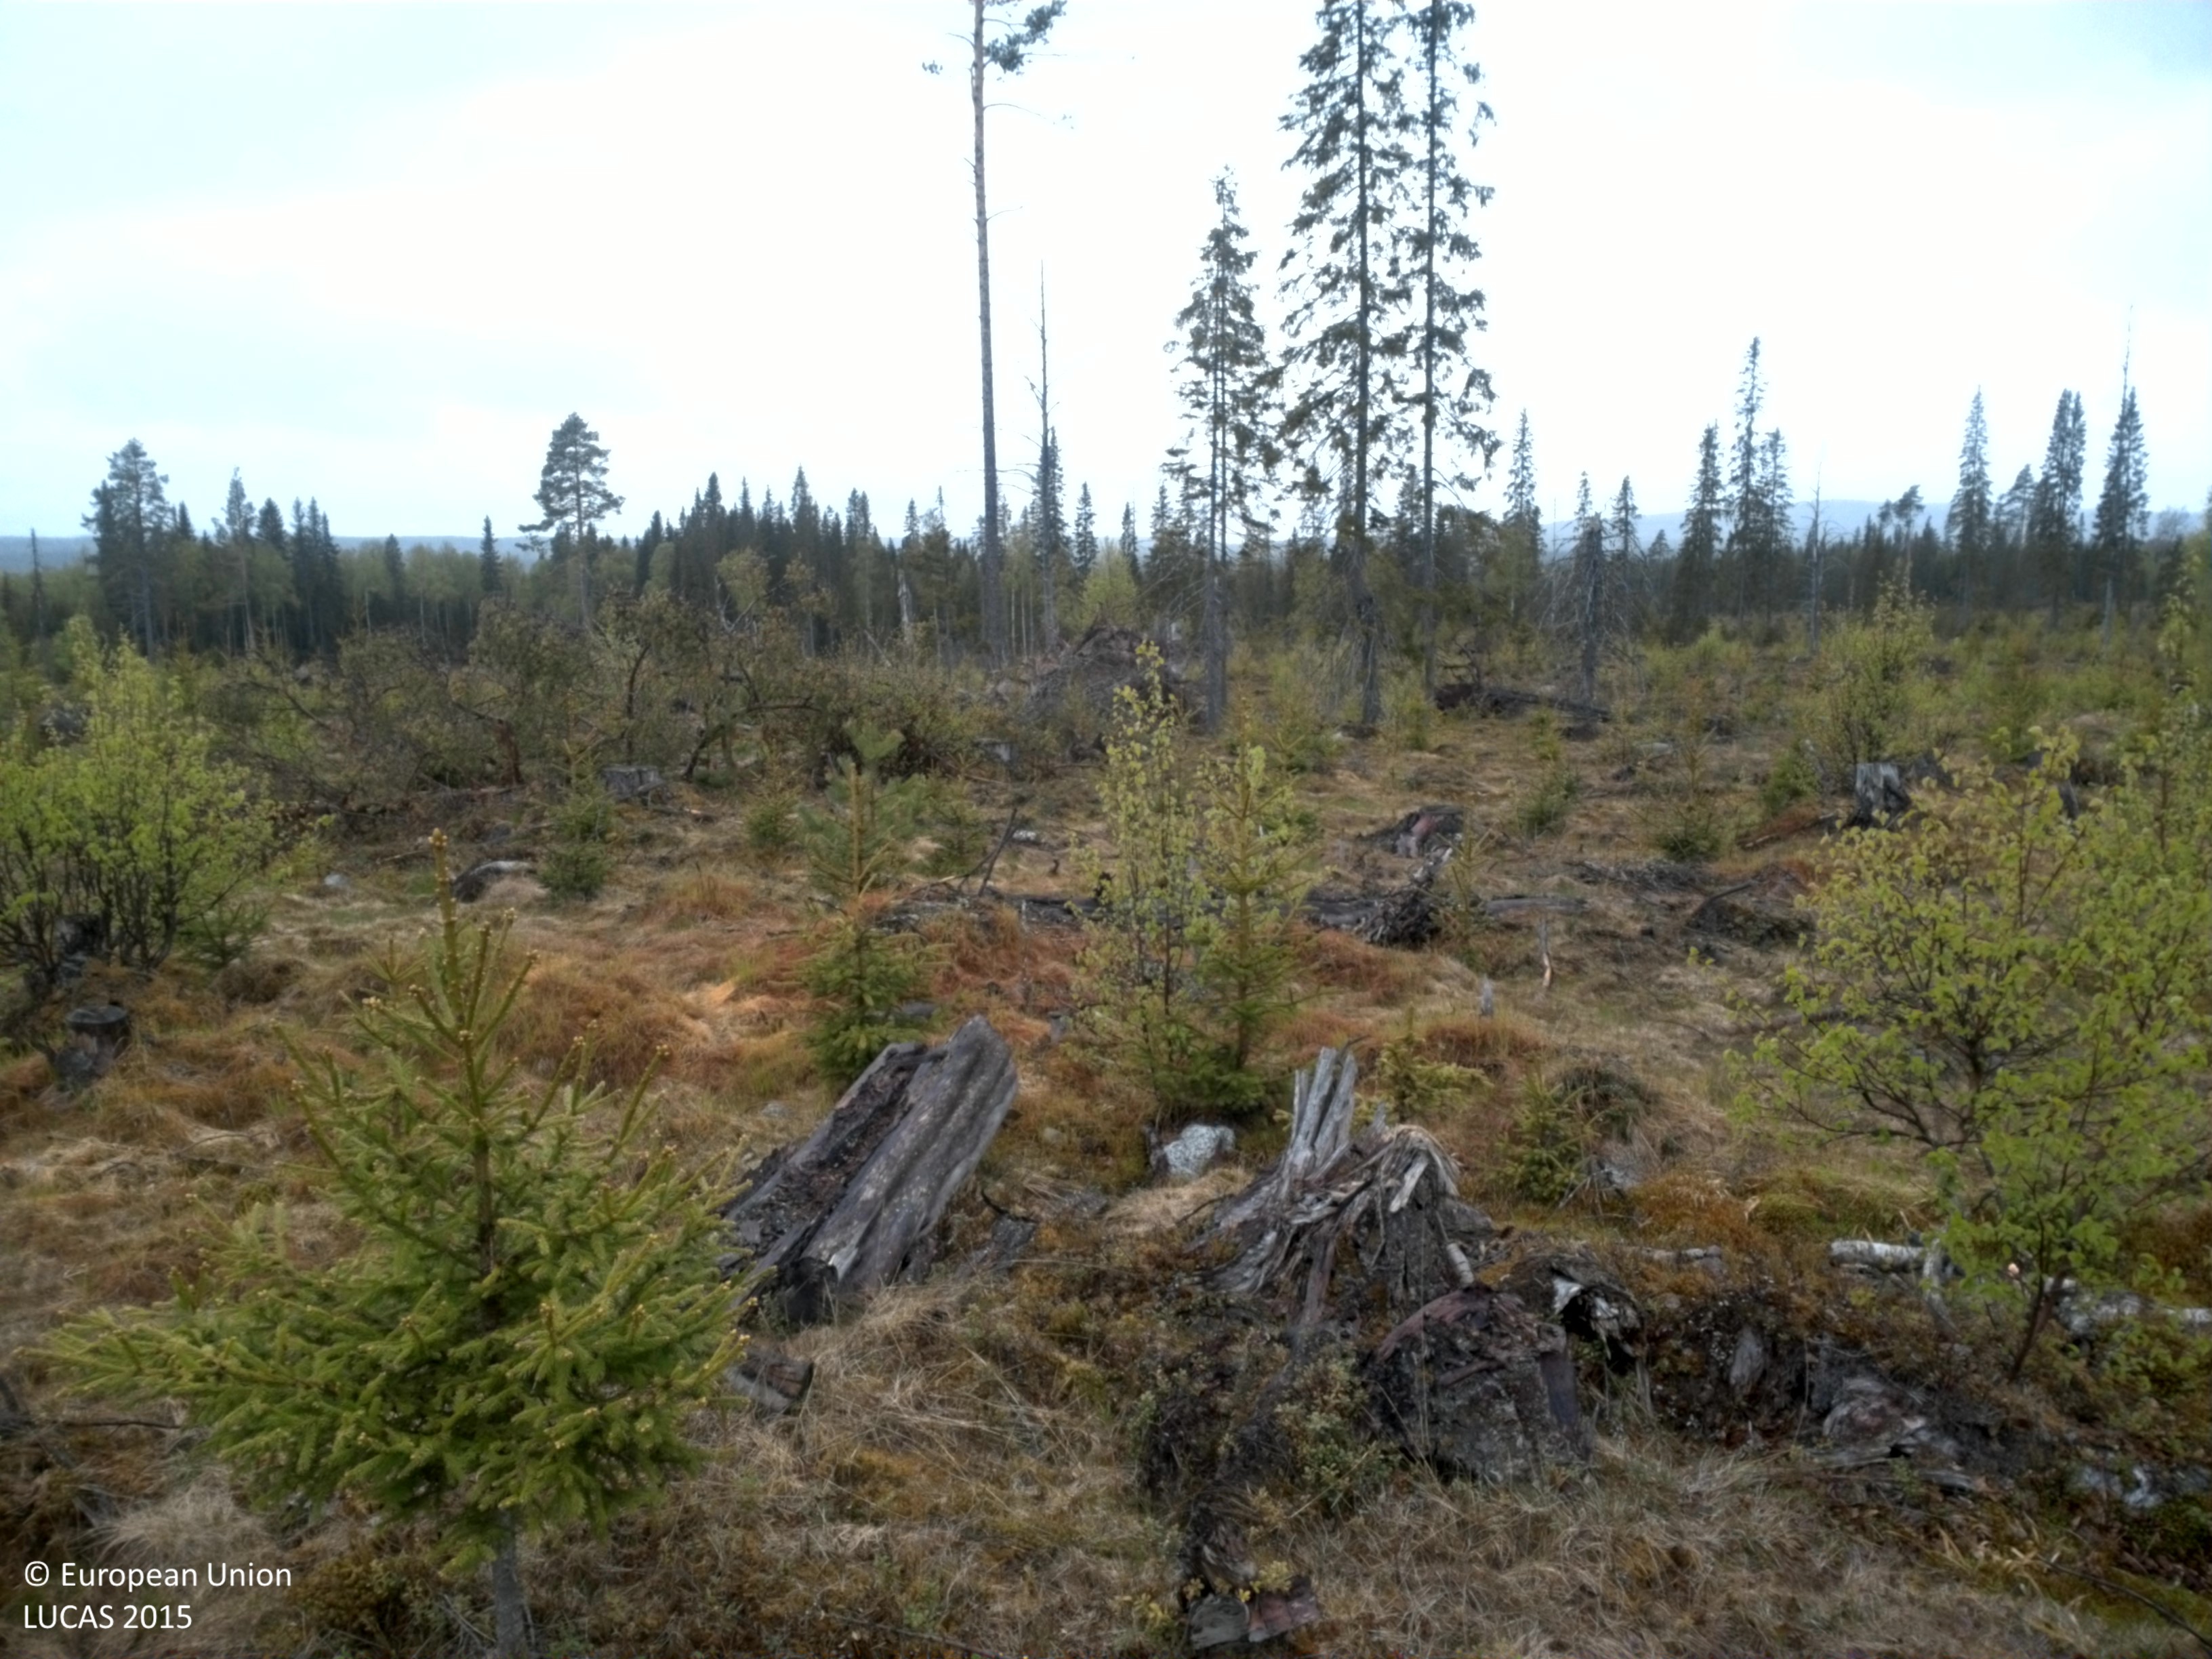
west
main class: Woodland
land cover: Spruce dominated coniferous woodland
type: boreal forest
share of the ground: 10 - 25 %
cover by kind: herbaceous plants 40 %, lichens and mosses 30 %, coniferous forest trees 15 %, broadleaved forest trees 5 %, shrubs 5 %, unconsolidated bare surface 5 %
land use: Forestry
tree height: < 5 m
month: June
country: SE
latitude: 64.4043
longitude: 17.4571
